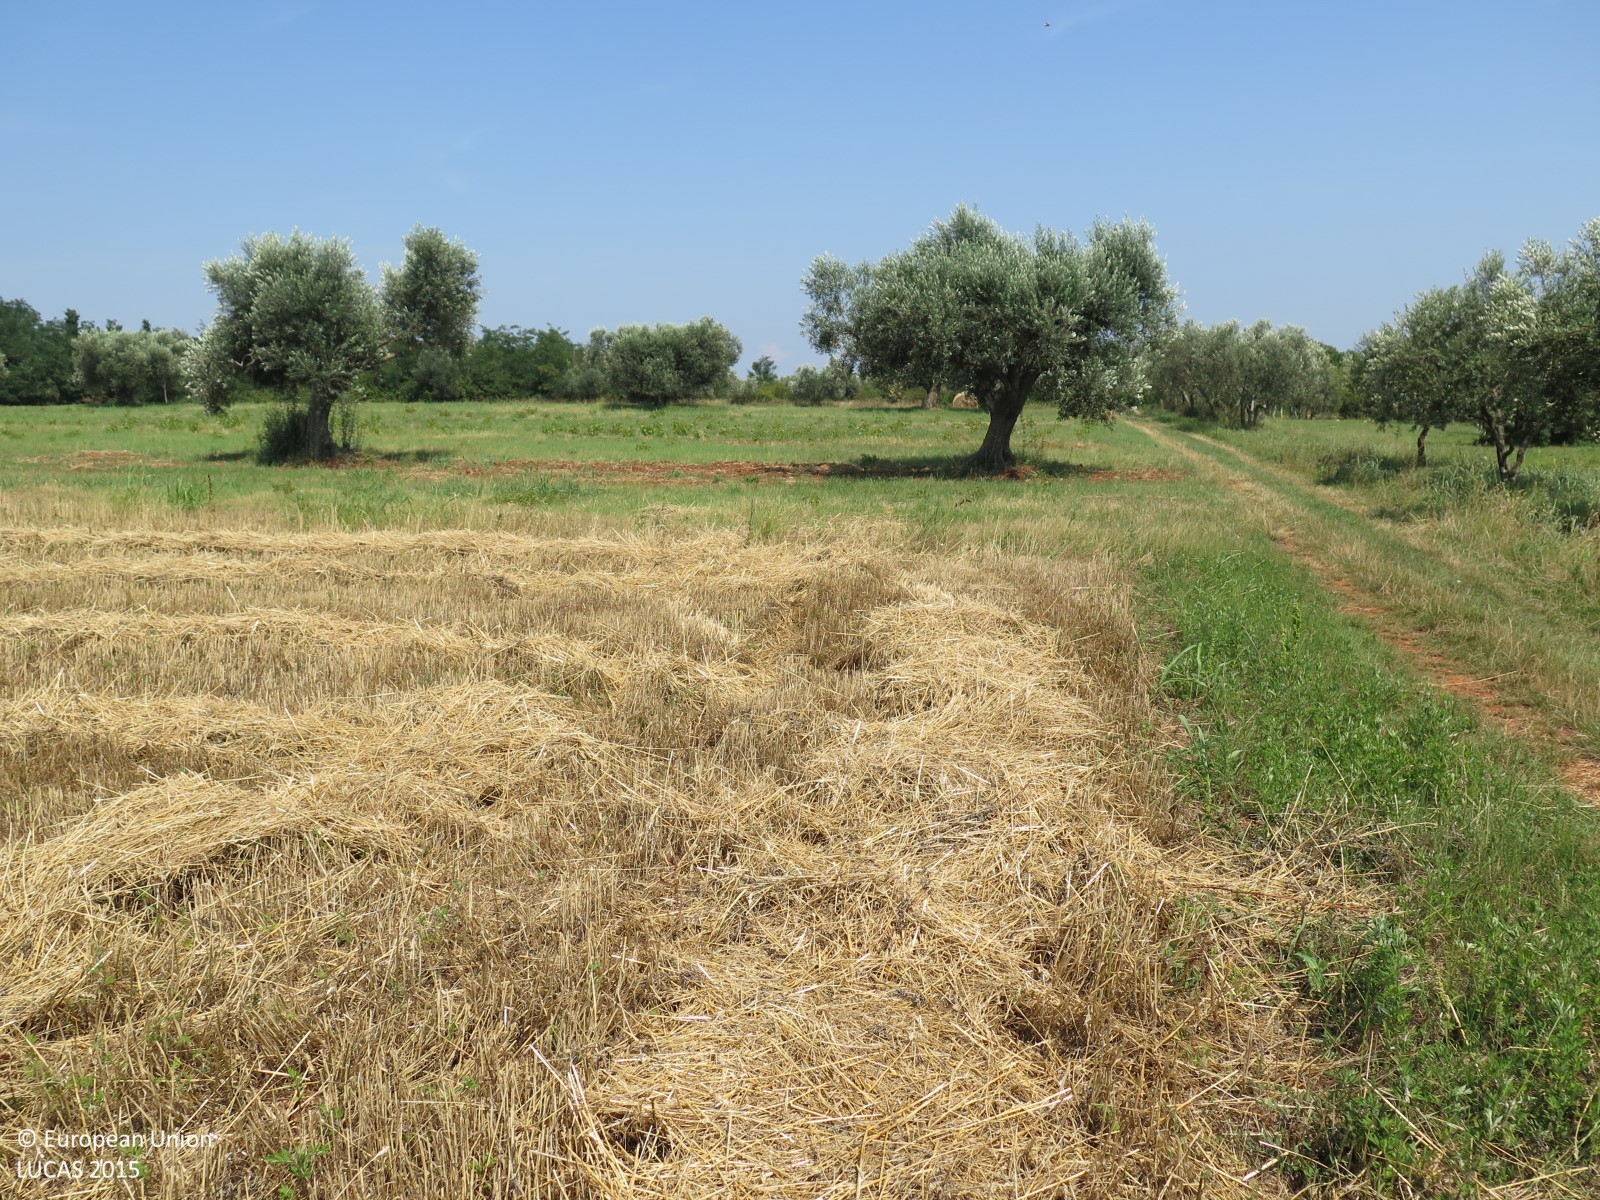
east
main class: Cropland
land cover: Oats
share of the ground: > 75 %
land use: Agriculture (excluding fallow land and kitchen gardens)
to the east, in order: Oats; Grass margins; Olive groves; Grass margins; Vineyards; Olive groves; Temporary grasslands; Shrubland without tree cover; Tracks; Grass margins; Olive groves
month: July
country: HR
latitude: 45.4623
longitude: 13.5635
